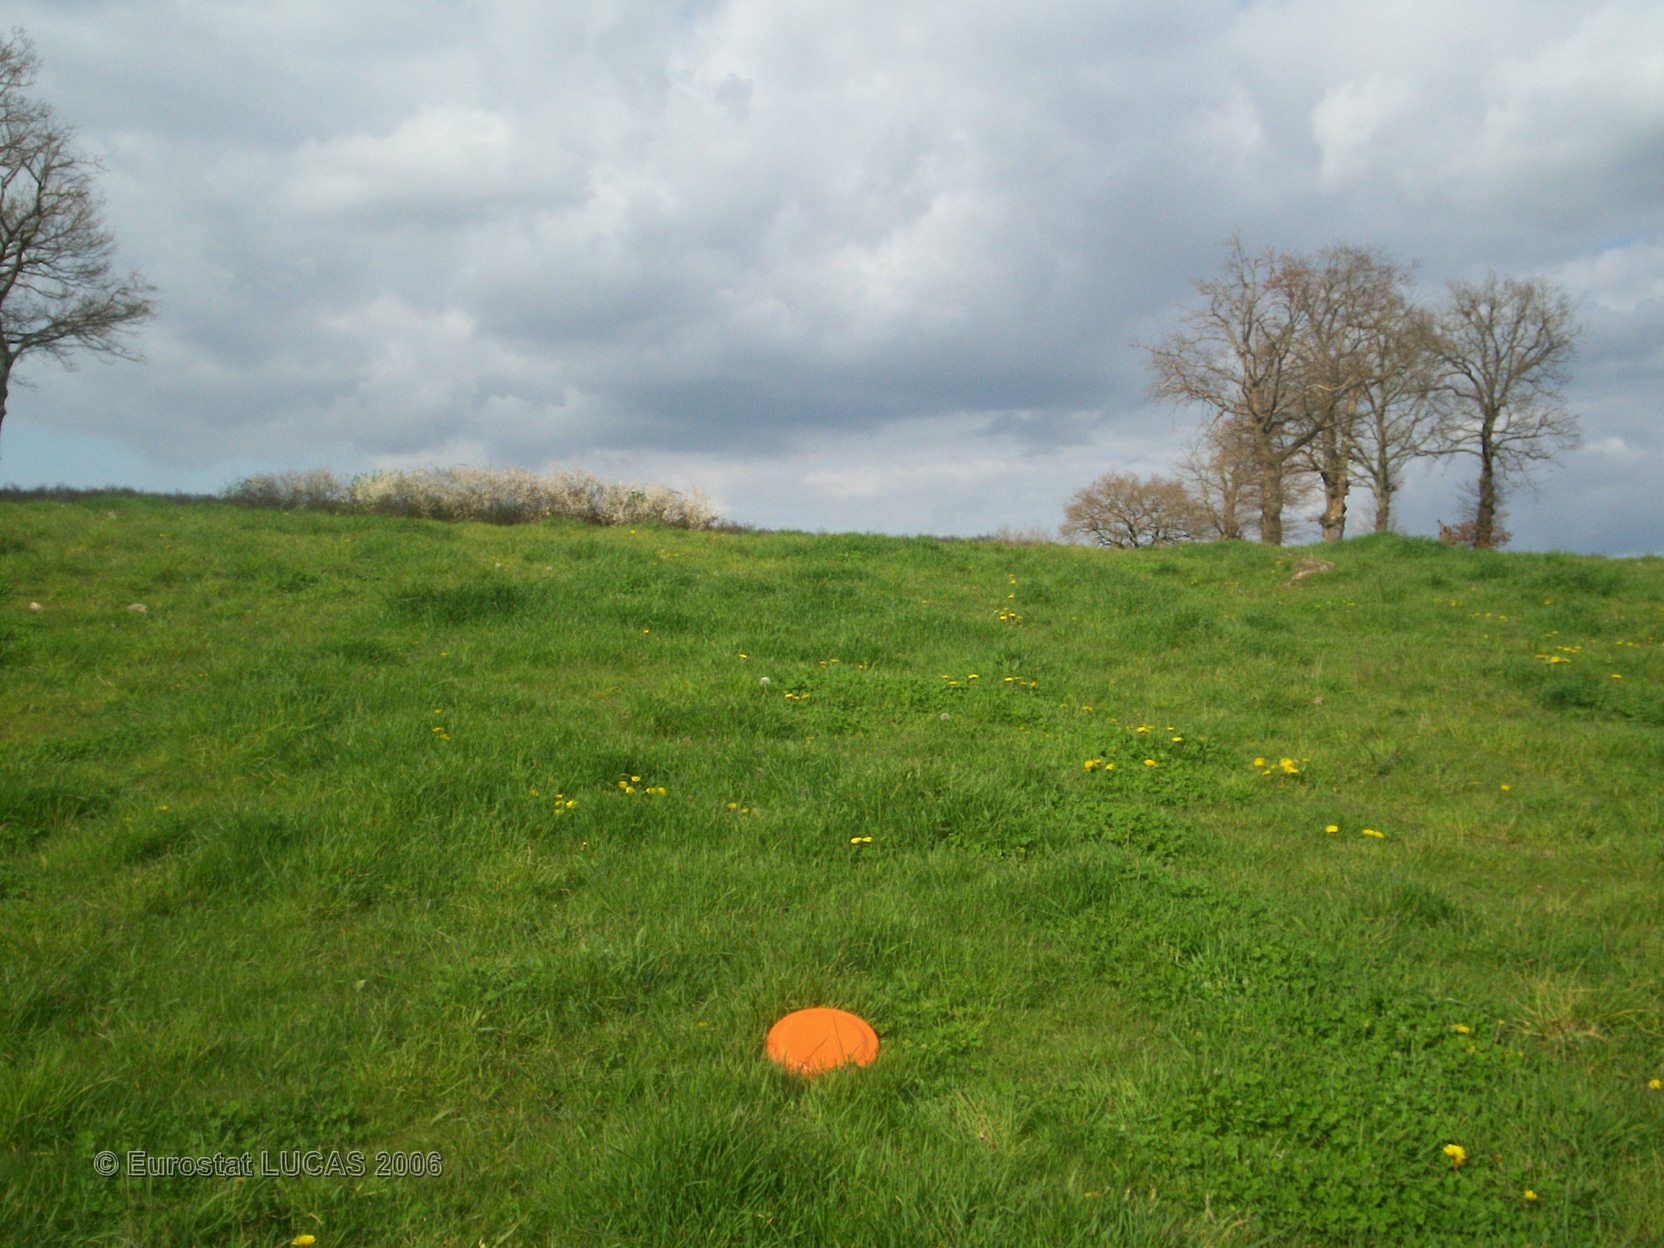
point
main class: Grassland
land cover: Grassland without tree/shrub cover
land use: Agriculture (excluding fallow land and kitchen gardens)
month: April
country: FR
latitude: 46.4302
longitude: 1.0728
